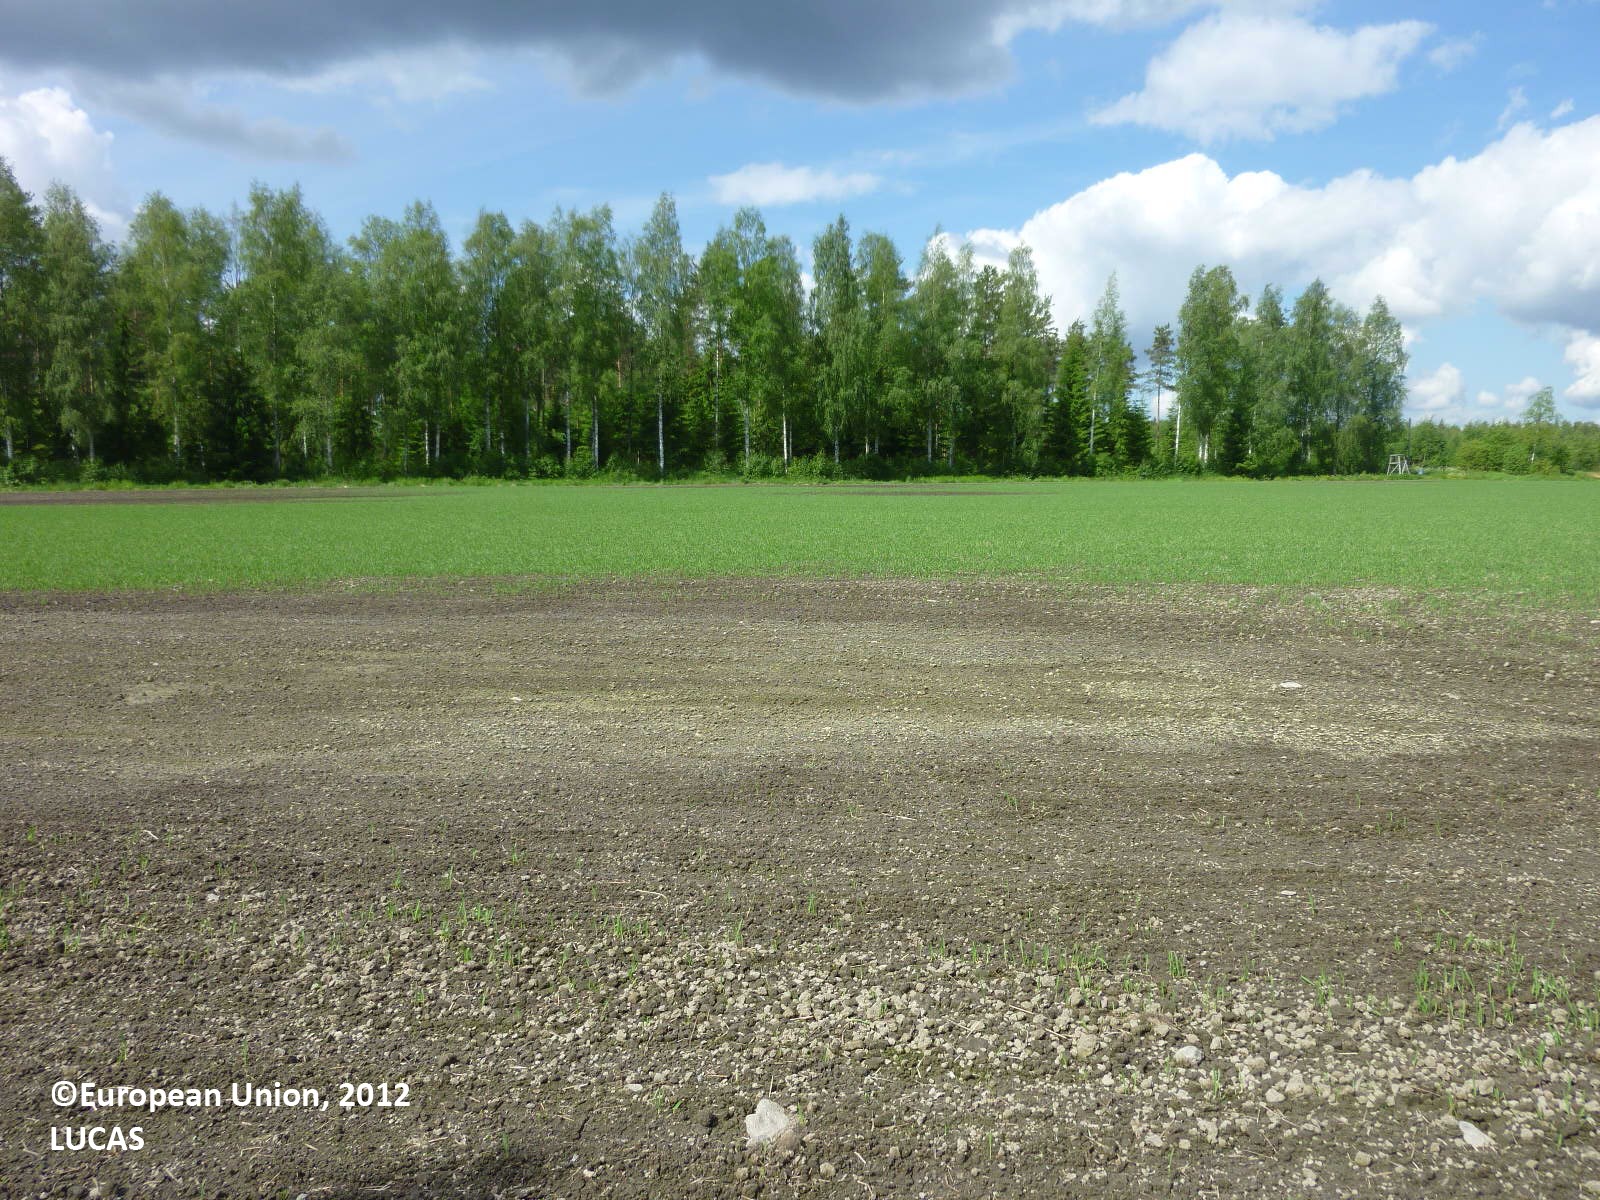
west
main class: Cropland
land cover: Oats
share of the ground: 25 - 50 %
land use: Agriculture (excluding fallow land and kitchen gardens)
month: June
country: FI
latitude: 61.3928
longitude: 22.5148
